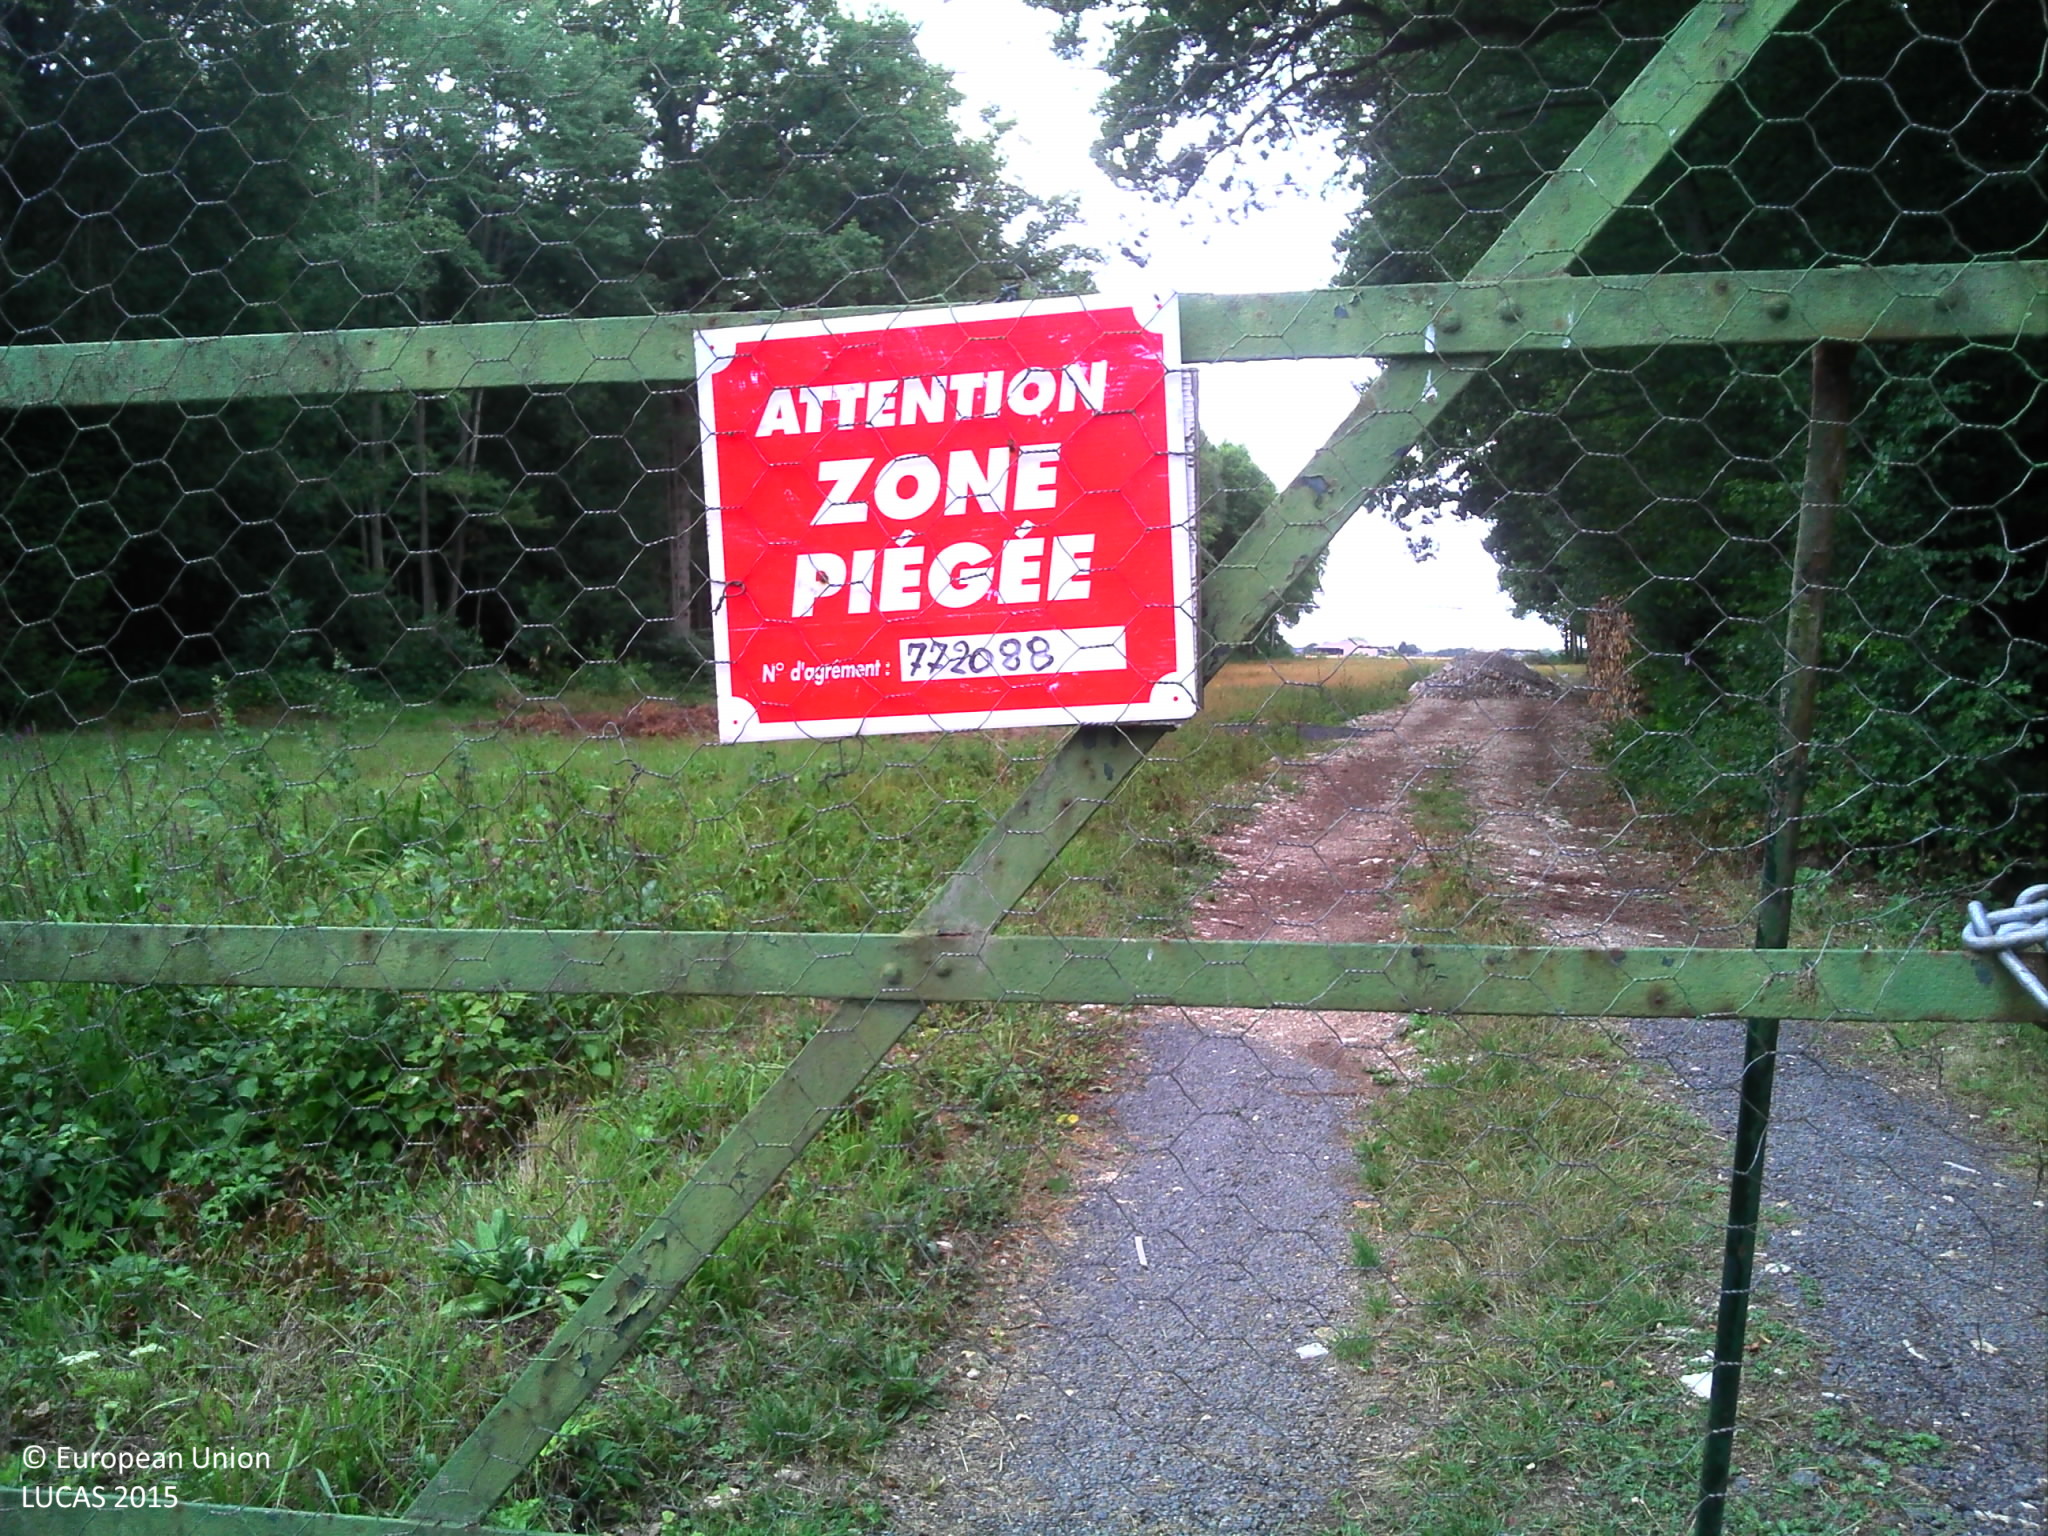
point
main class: Woodland
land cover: Broadleaved woodland
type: acidophilous oak and oak-birch forest
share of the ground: > 75 %
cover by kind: broadleaved forest trees 100 %
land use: Forestry
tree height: > 5 m
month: July
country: FR
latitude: 48.7214
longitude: 2.6905
